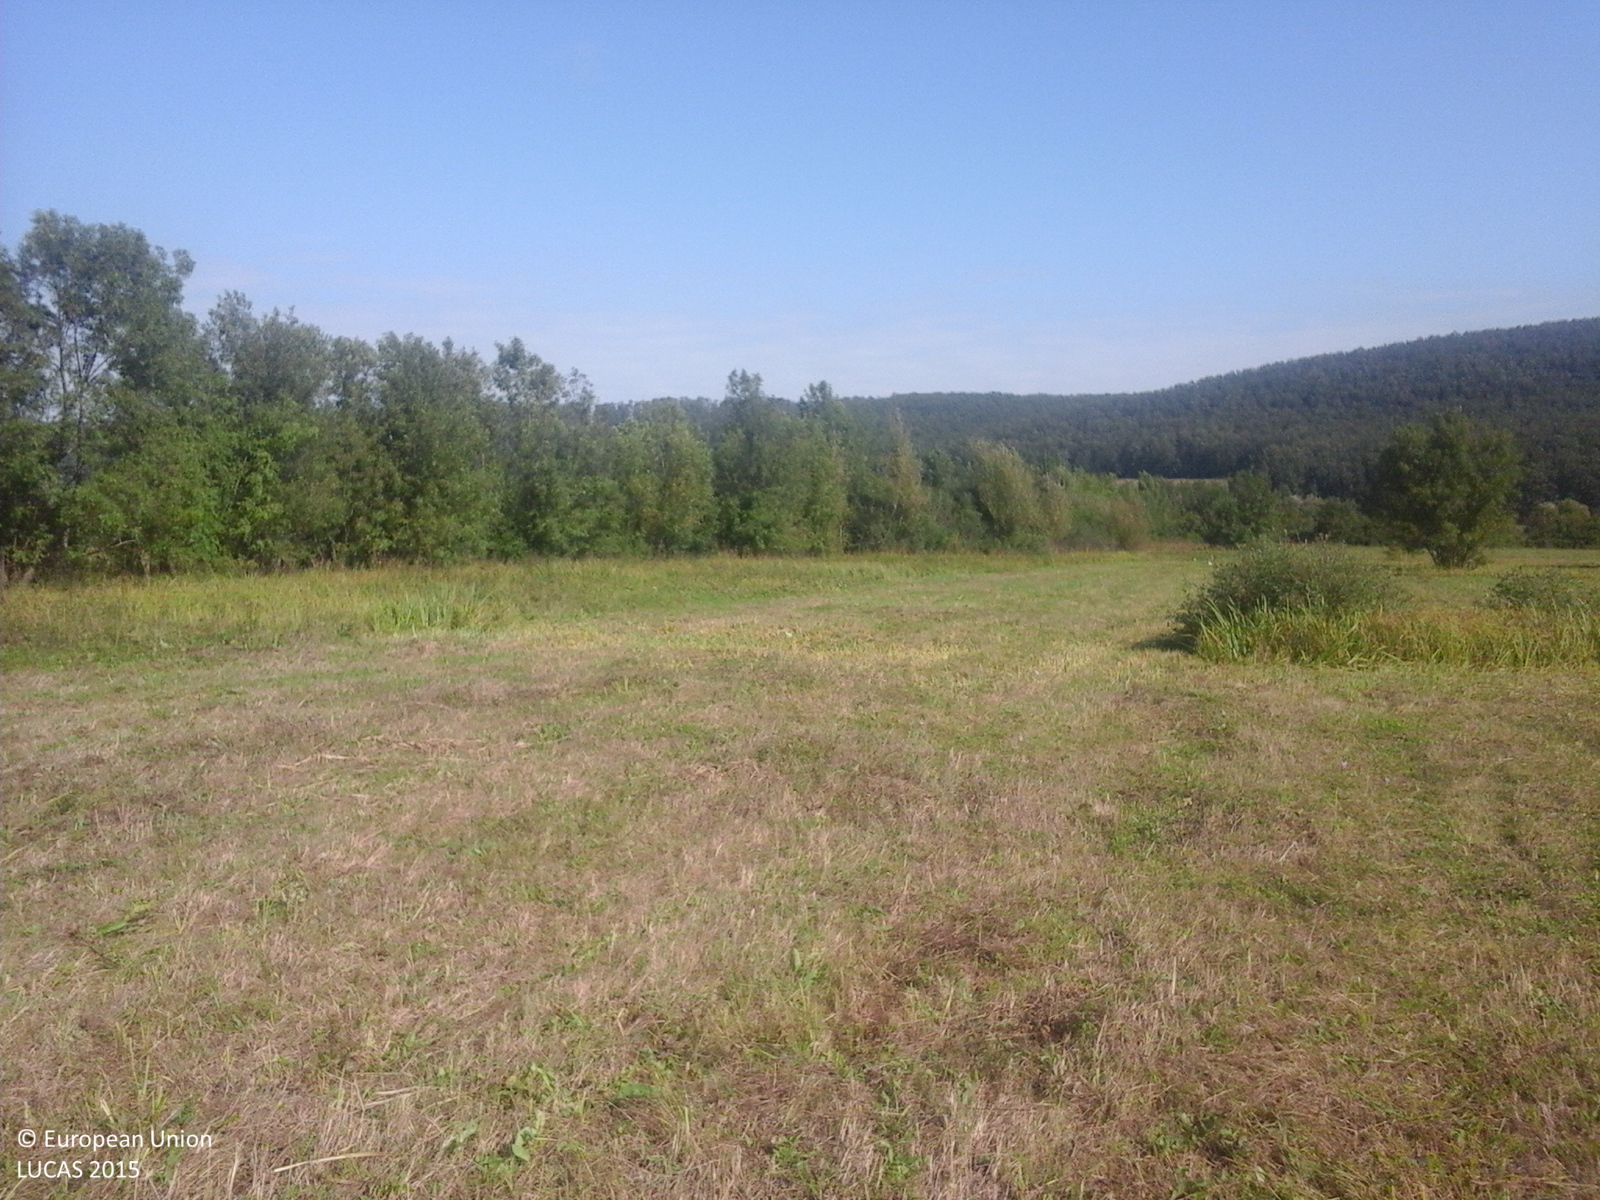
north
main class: Grassland
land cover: Grassland without tree/shrub cover
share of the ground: > 75 %
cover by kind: herbaceous plants 100 %
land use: Agriculture (excluding fallow land and kitchen gardens)
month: September
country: RO
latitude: 47.4337
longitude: 22.8299
